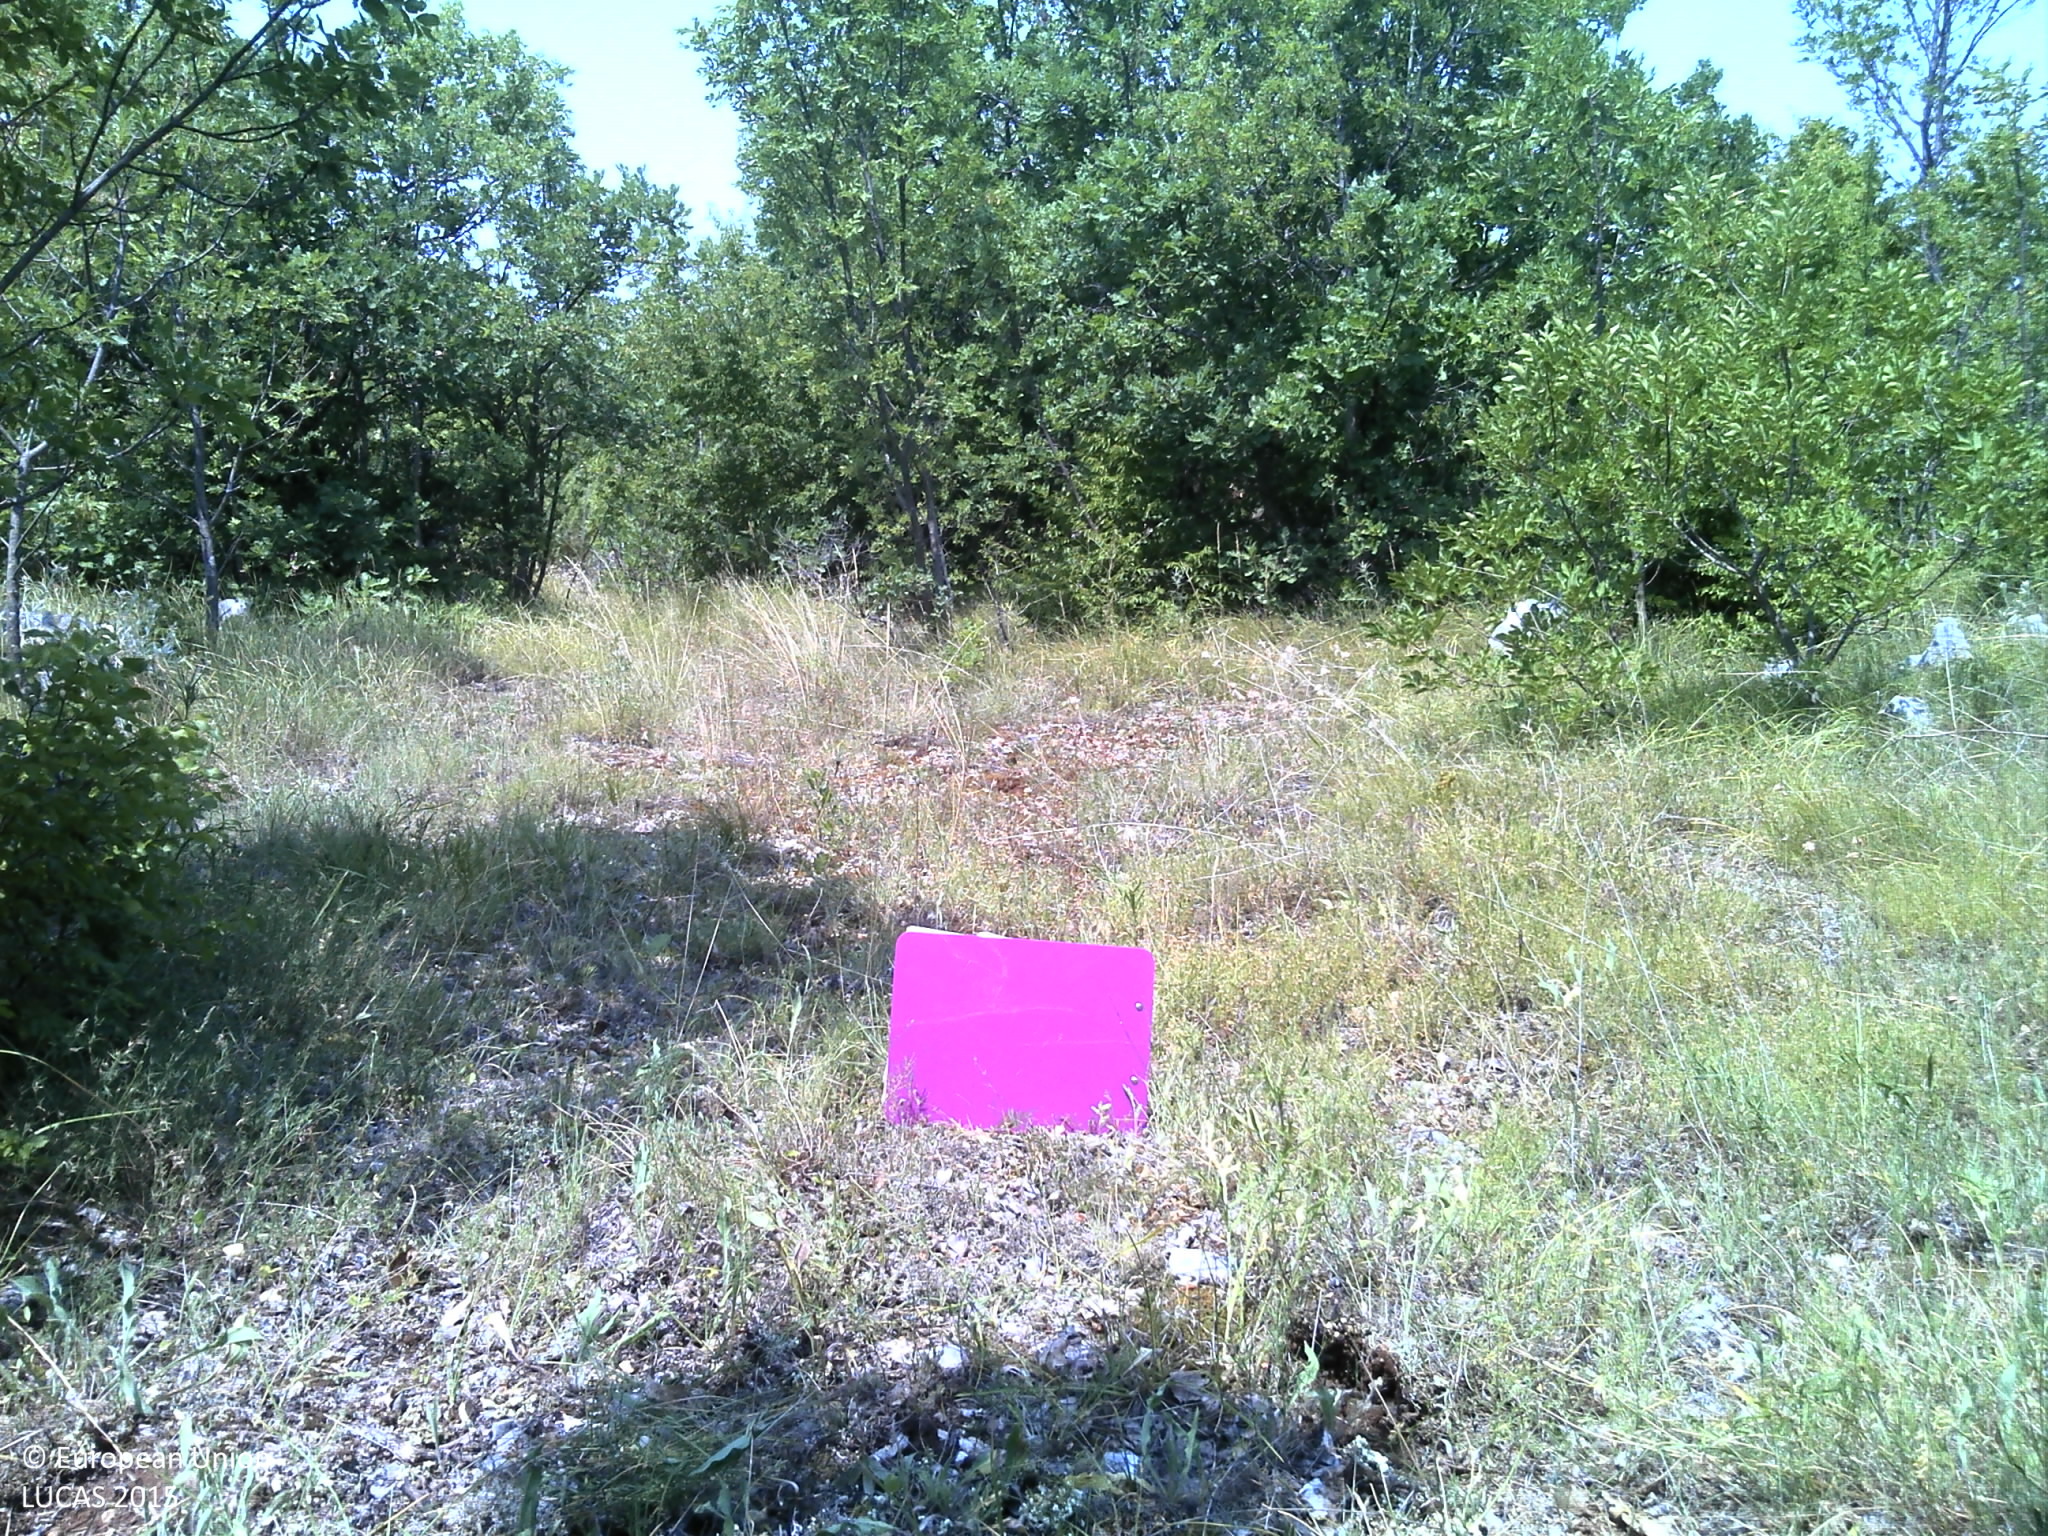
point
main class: Shrubland
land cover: Shrubland with sparse tree cover
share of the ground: > 75 %
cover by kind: shrubs 70 %, herbaceous plants 10 %, unconsolidated bare surface 10 %, broadleaved forest trees 5 %, consolidated bare surface 5 %
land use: Semi-natural and natural areas not in use
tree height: > 5 m
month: July
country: HR
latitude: 43.5196
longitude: 16.9568
